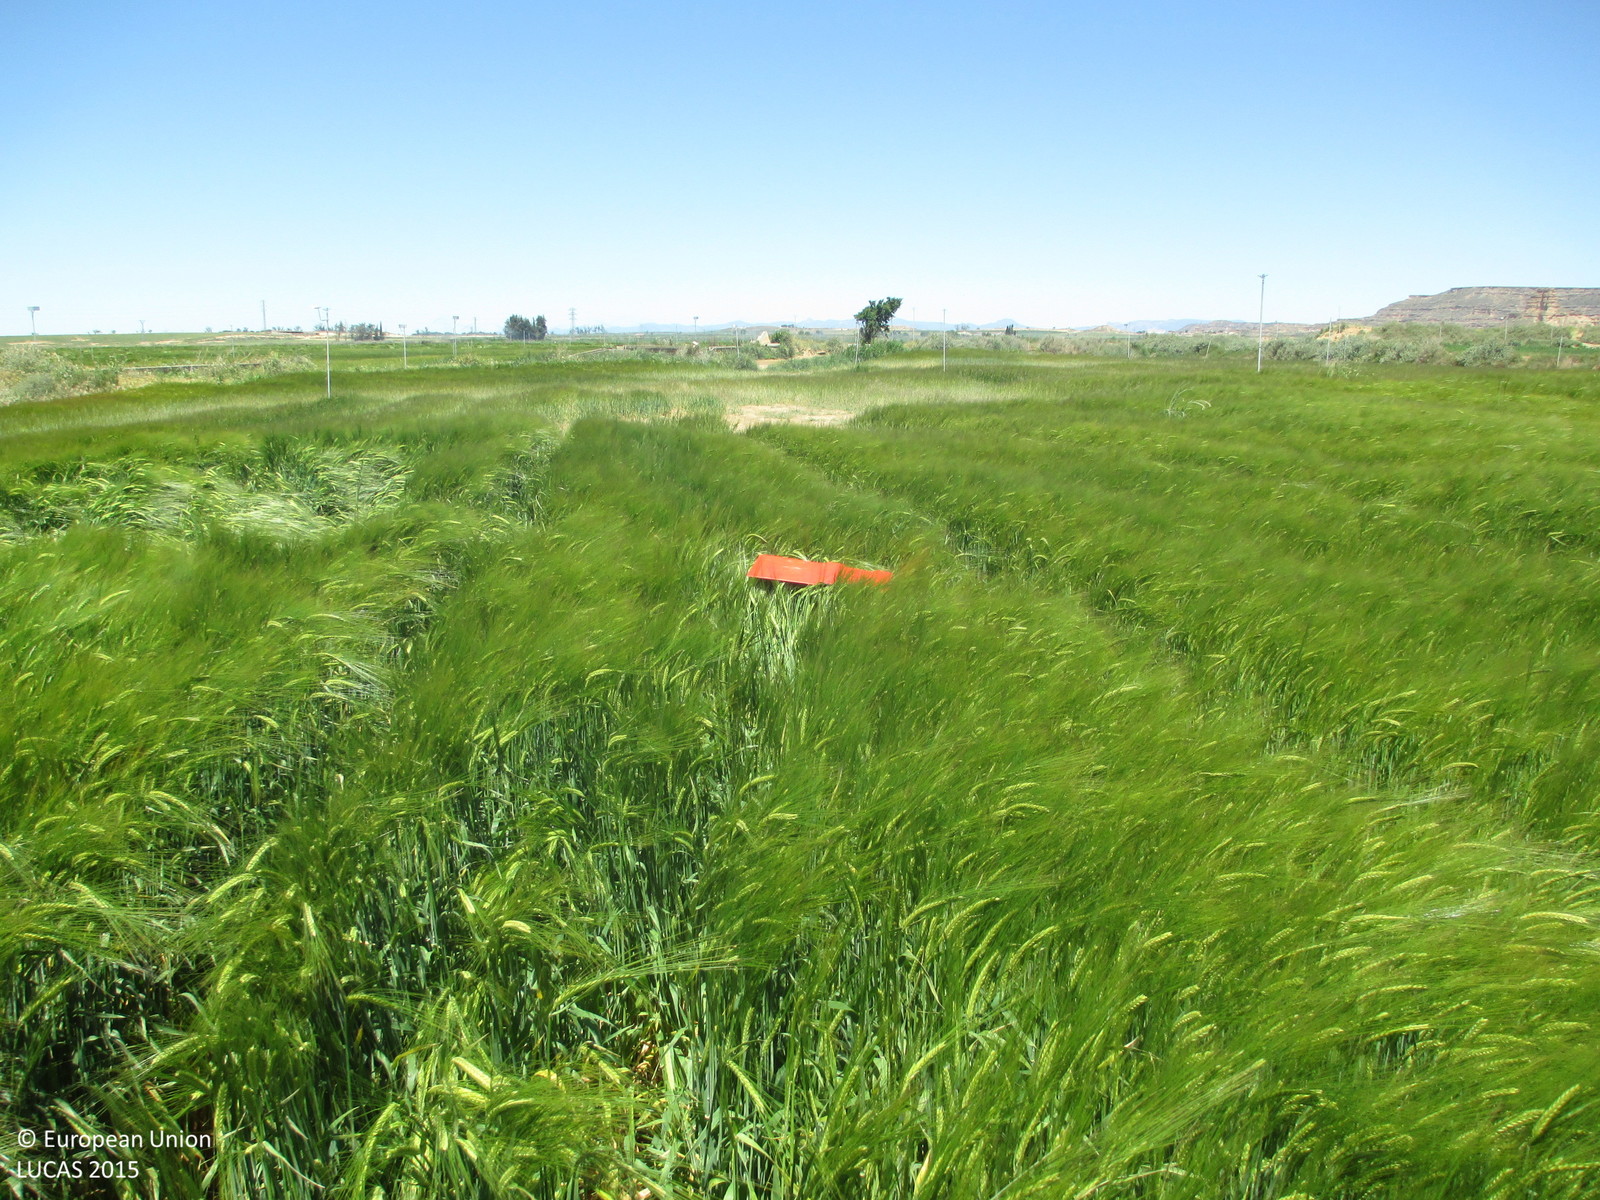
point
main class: Cropland
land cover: Barley
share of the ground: > 75 %
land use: Agriculture (excluding fallow land and kitchen gardens)
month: May
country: ES
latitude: 41.8935
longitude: -0.2765
